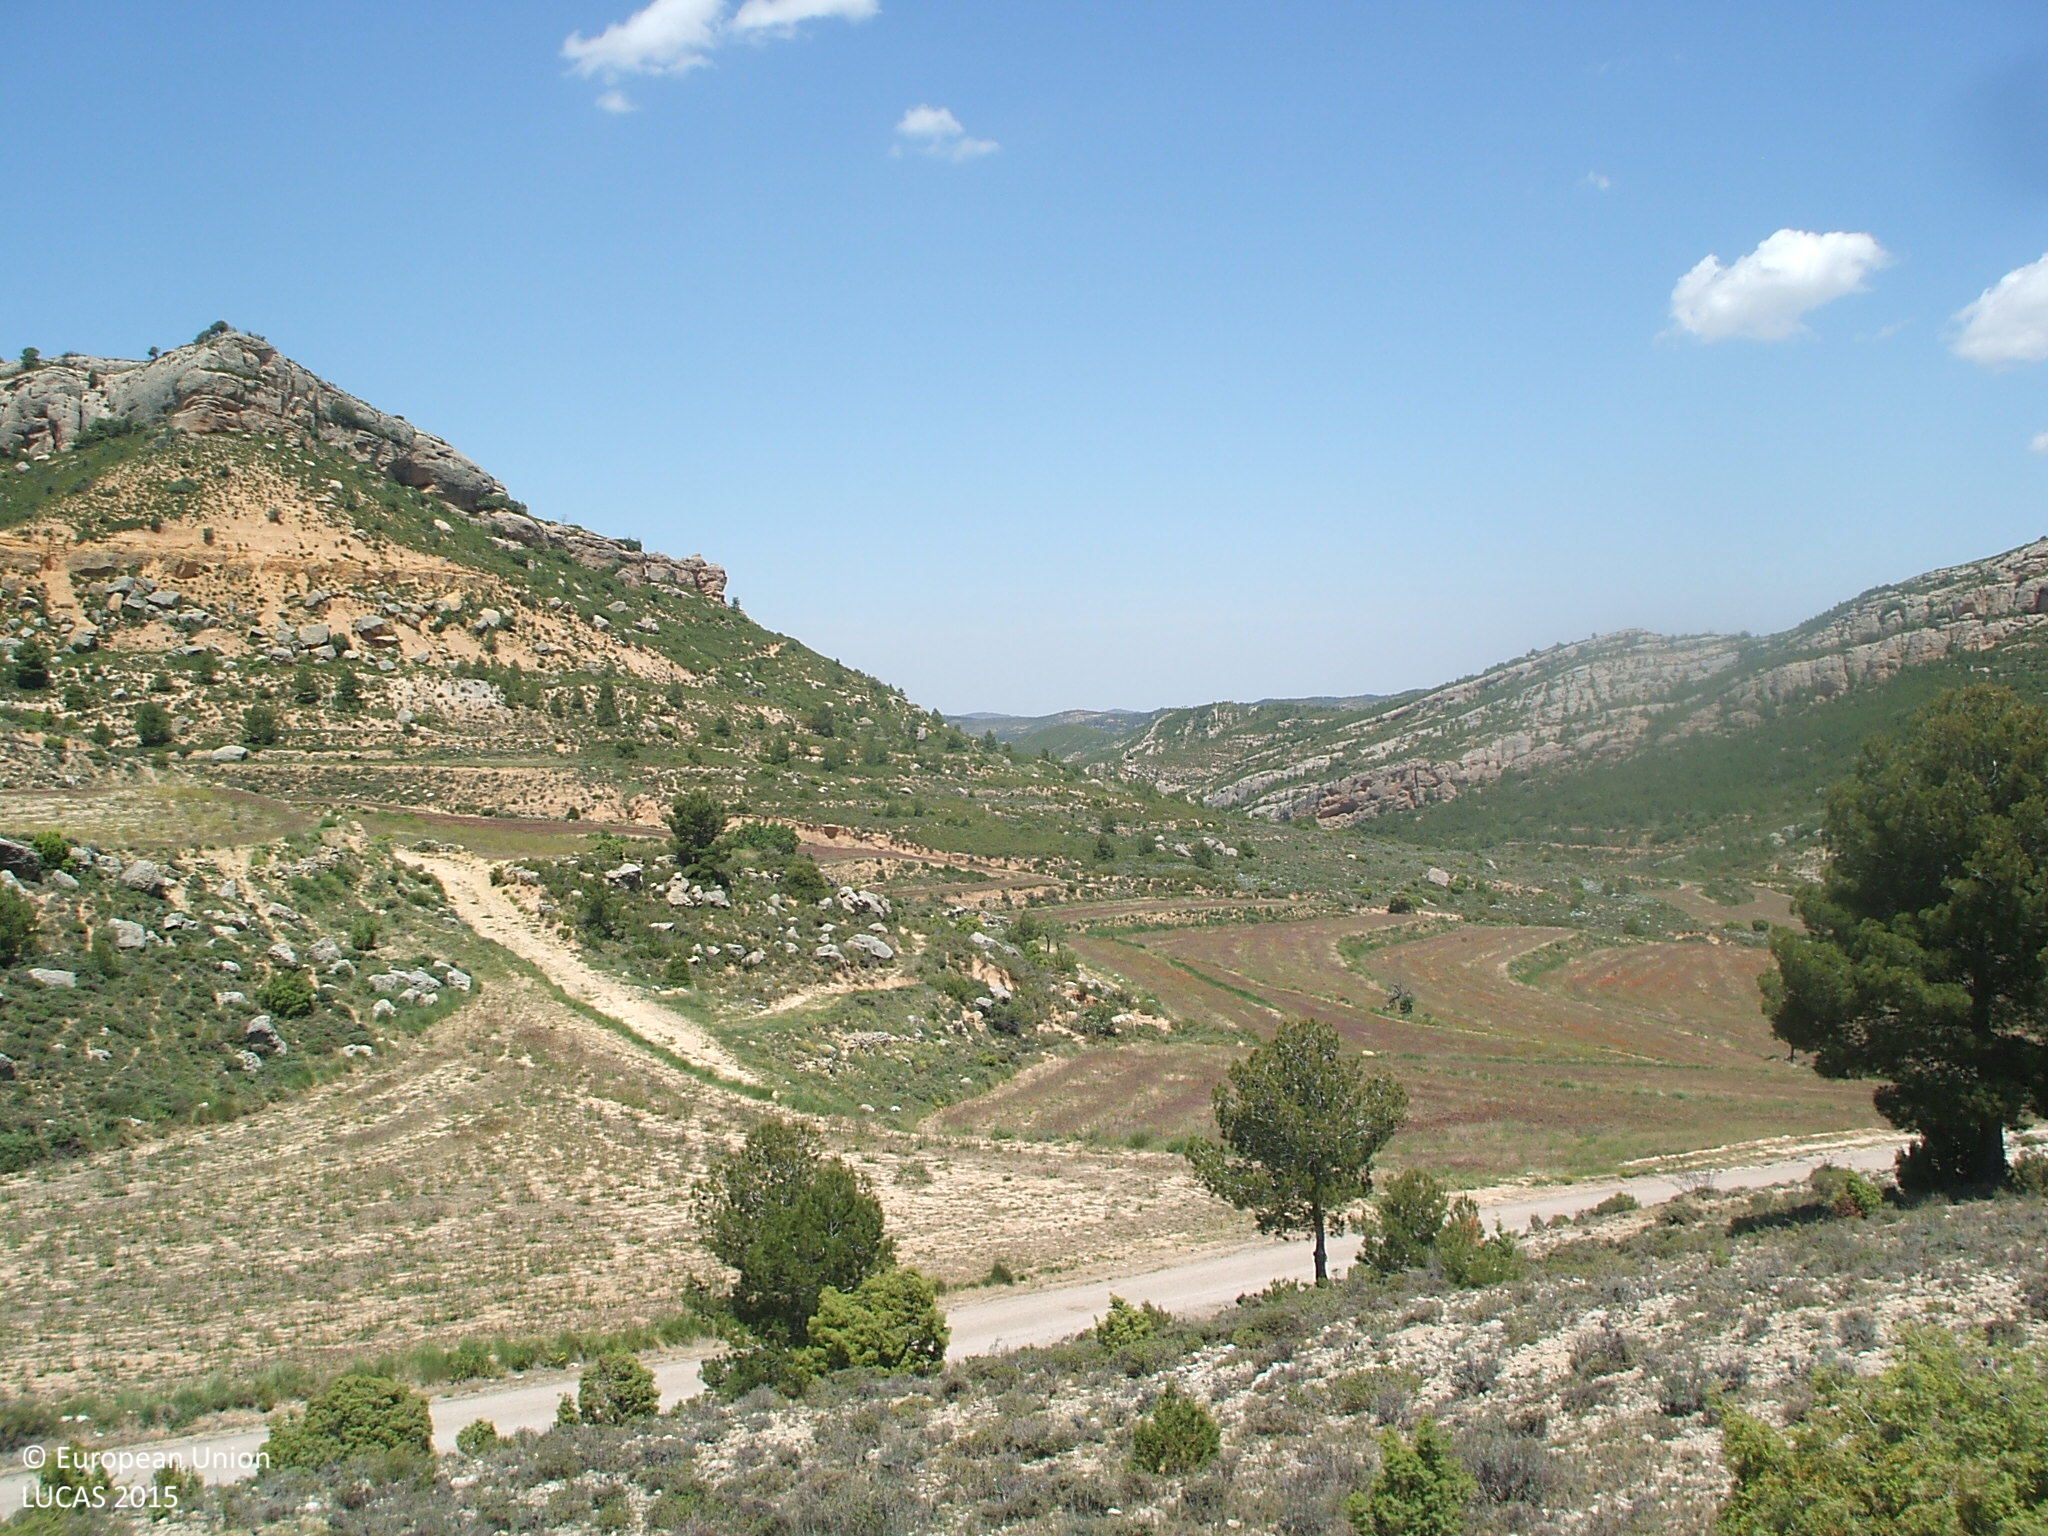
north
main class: Shrubland
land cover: Shrubland with sparse tree cover
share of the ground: 25 - 50 %
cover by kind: consolidated bare surface 55 %, shrubs 20 %, herbaceous plants 20 %, broadleaved forest trees 5 %
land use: Agriculture (excluding fallow land and kitchen gardens)
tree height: > 5 m
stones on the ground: > 50 %
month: May
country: ES
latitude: 40.6928
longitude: -0.2687
